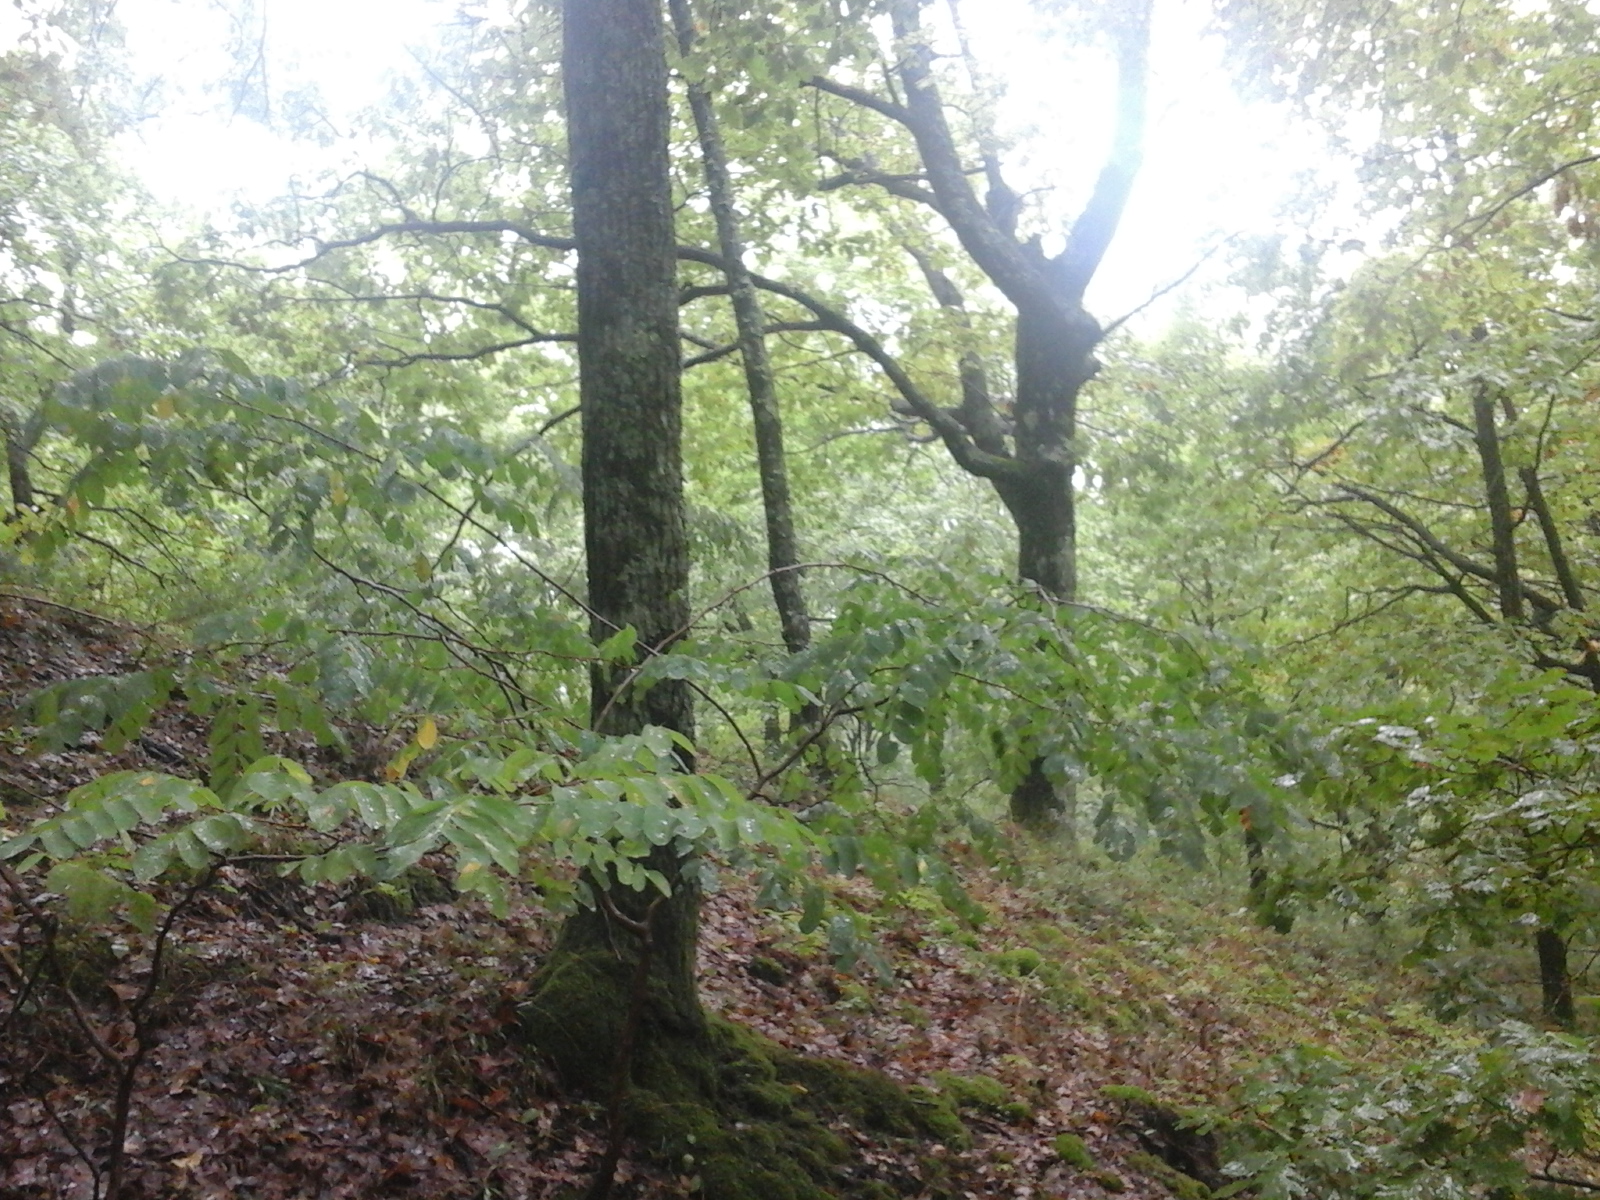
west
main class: Woodland
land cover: Broadleaved woodland
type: acidophilous oak and oak-birch forest
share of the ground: > 75 %
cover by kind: broadleaved forest trees 100 %
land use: Forestry
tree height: > 5 m
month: September
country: RO
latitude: 44.9308
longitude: 23.7323
